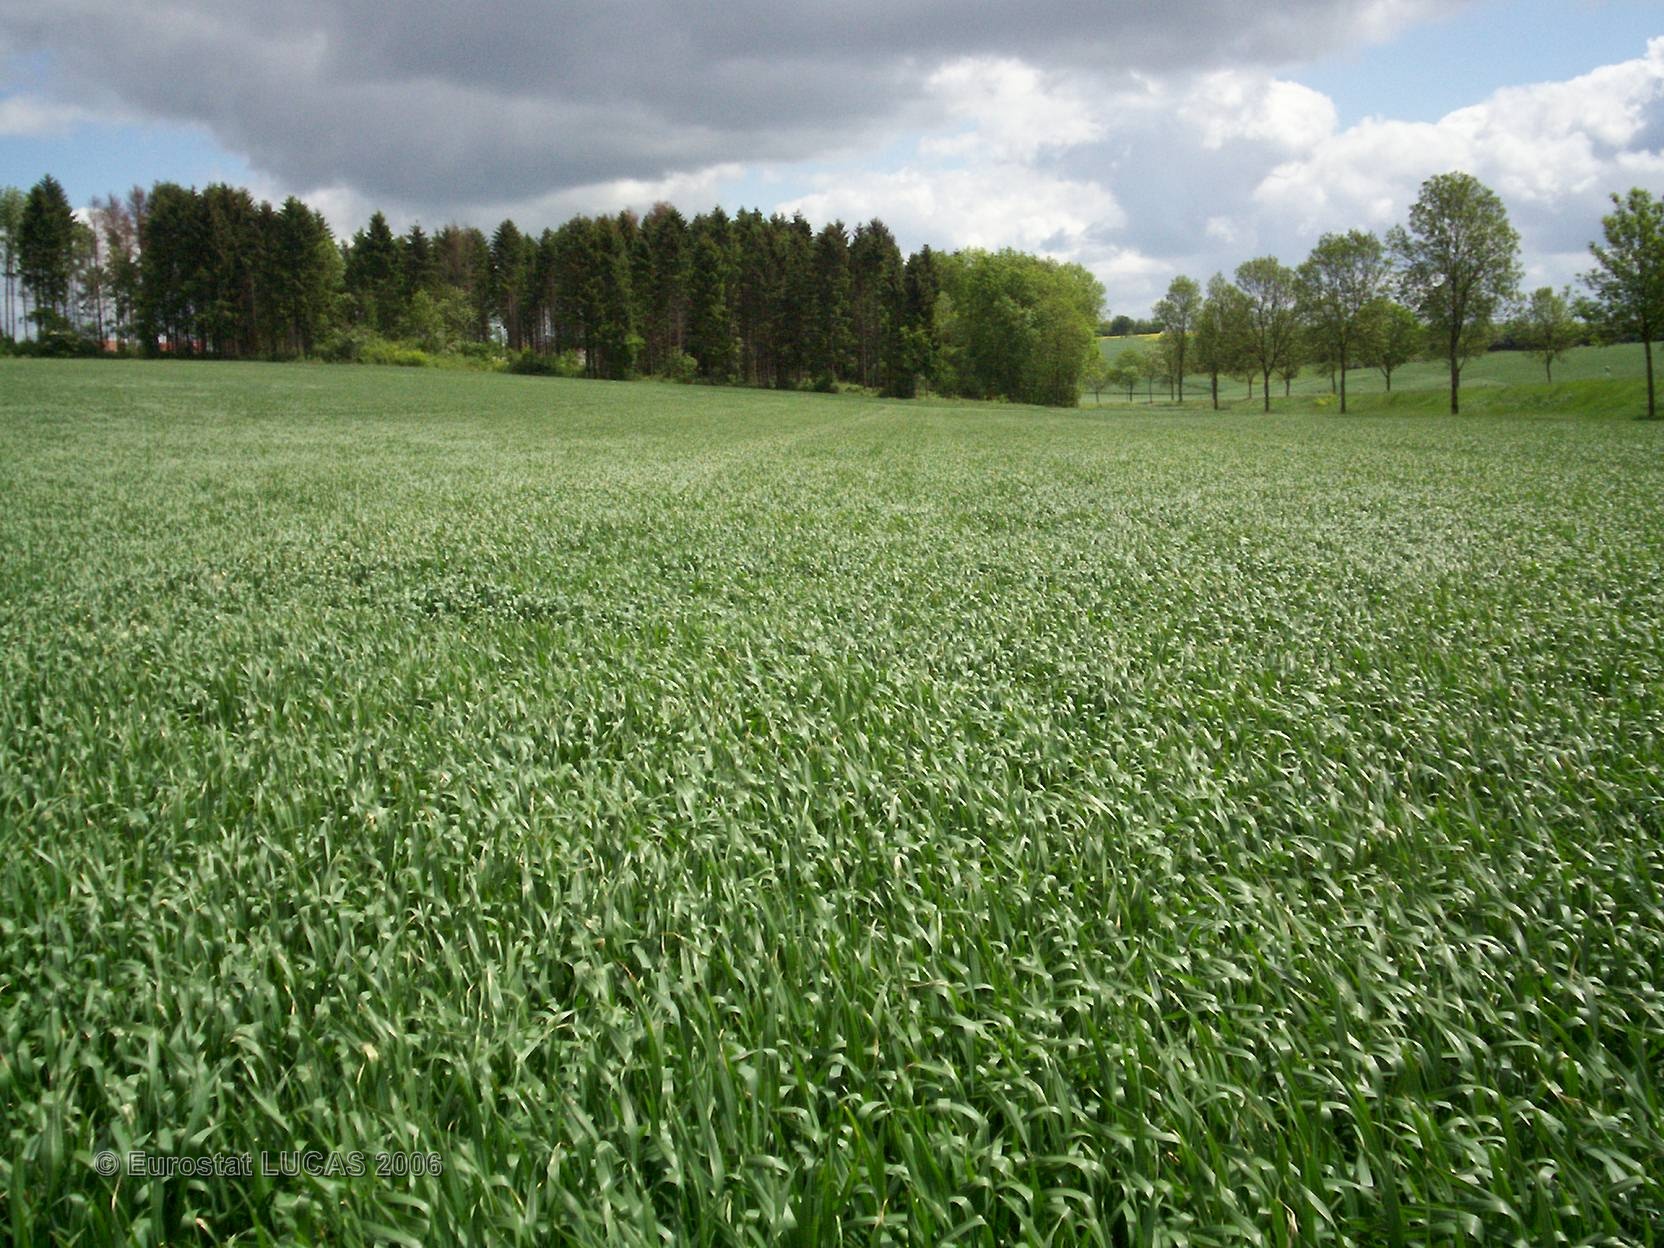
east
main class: Cropland
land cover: Common wheat
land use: Agriculture (excluding fallow land and kitchen gardens)
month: May
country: FR
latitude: 49.3526
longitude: 5.8554
